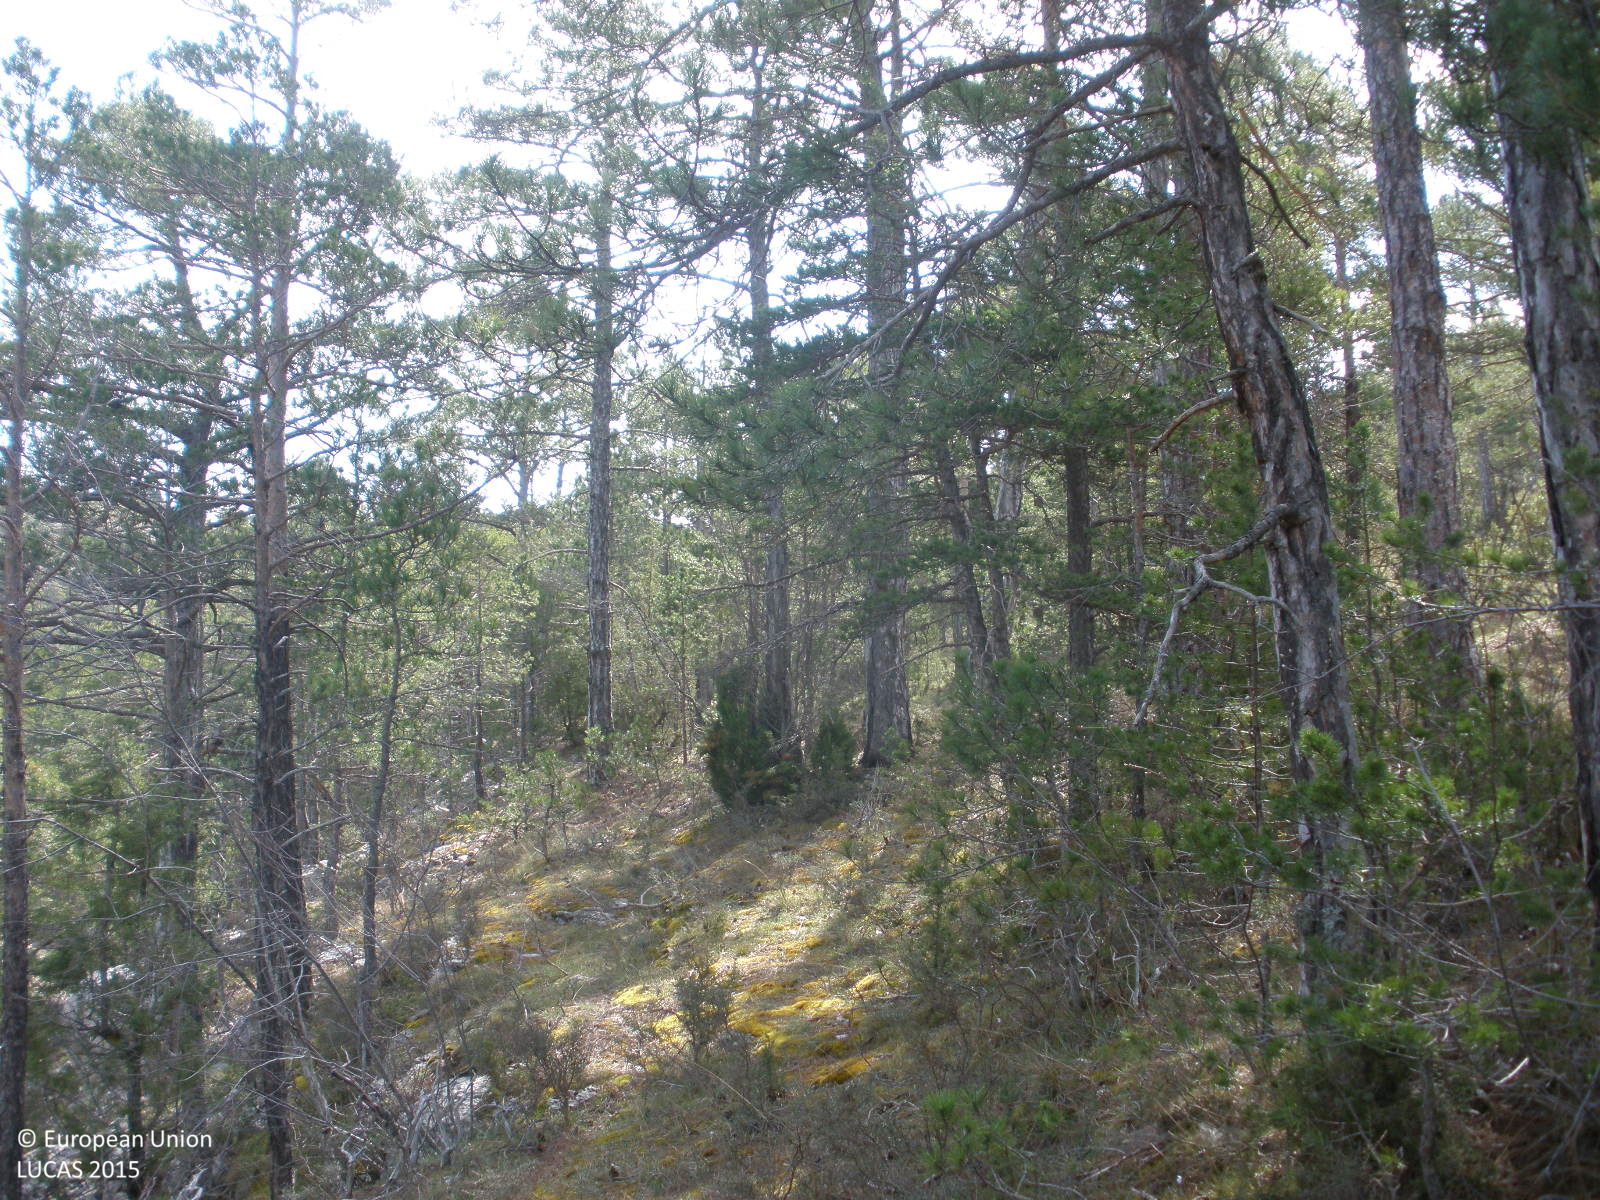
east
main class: Woodland
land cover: Pine dominated coniferous woodland
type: coniferous forest of the mediterranean region
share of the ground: > 75 %
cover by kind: coniferous forest trees 75 %, shrubs 15 %, herbaceous plants 10 %
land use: Semi-natural and natural areas not in use
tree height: > 5 m
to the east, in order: Pine dominated coniferous woodland; Tracks; Pine dominated coniferous woodland
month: April
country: ES
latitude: 40.3513
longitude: -0.7342
